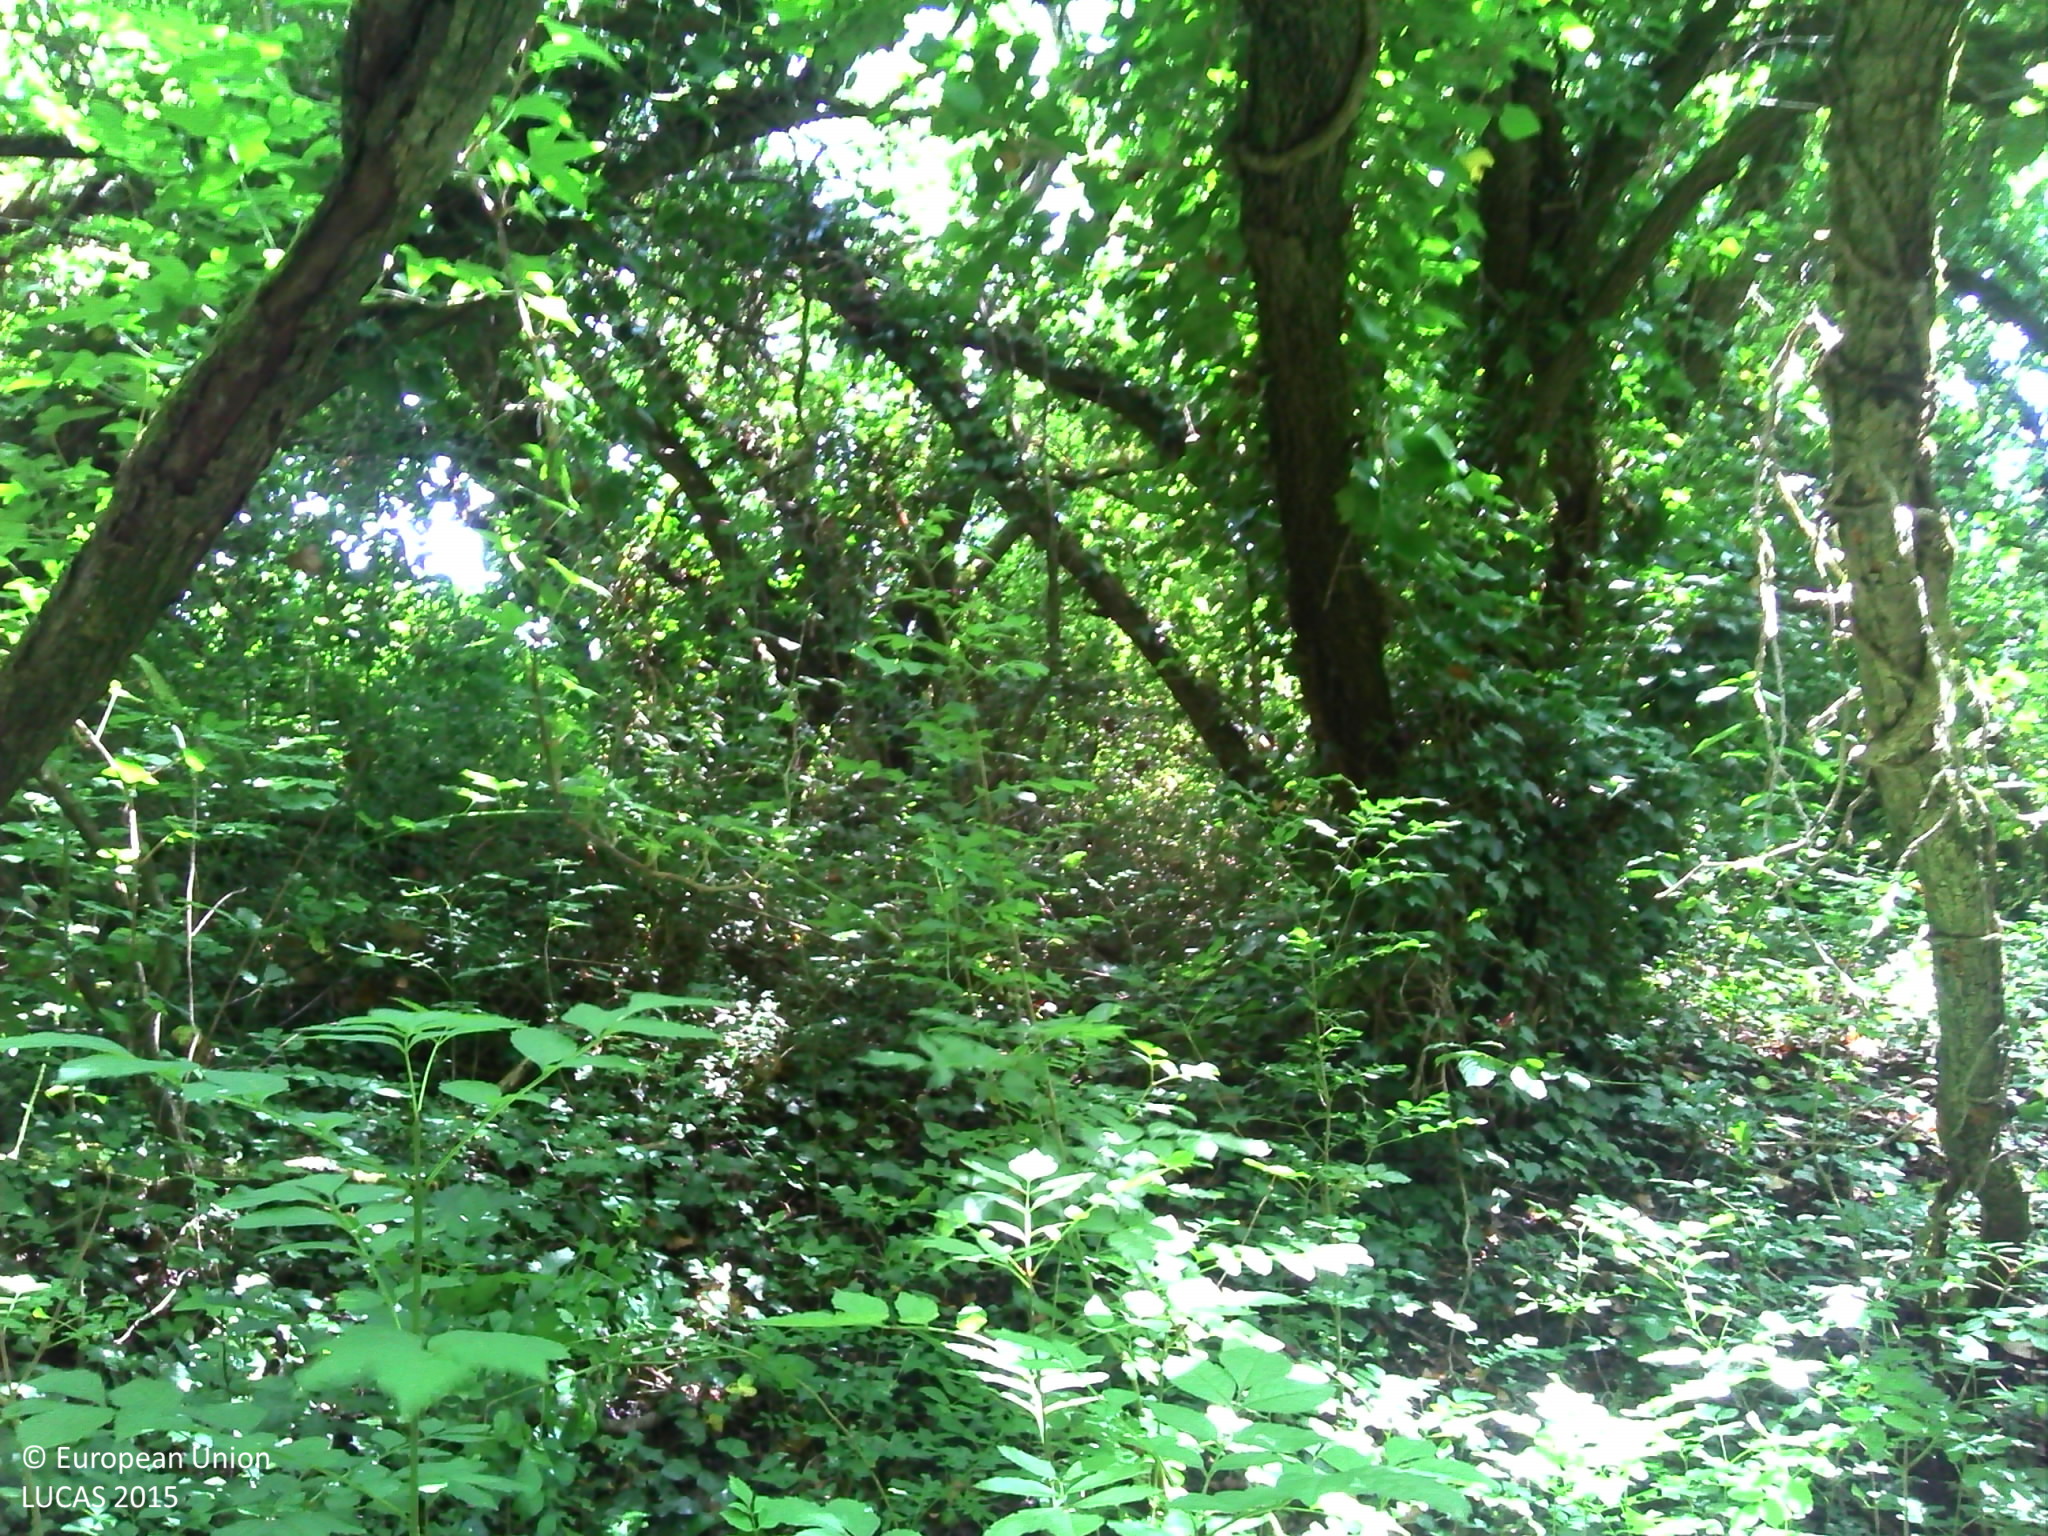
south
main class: Woodland
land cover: Broadleaved woodland
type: mesophytic deciduous forest
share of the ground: > 75 %
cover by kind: broadleaved forest trees 100 %
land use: Forestry
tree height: > 5 m
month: June
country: FR
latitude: 45.7305
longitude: -1.1449
